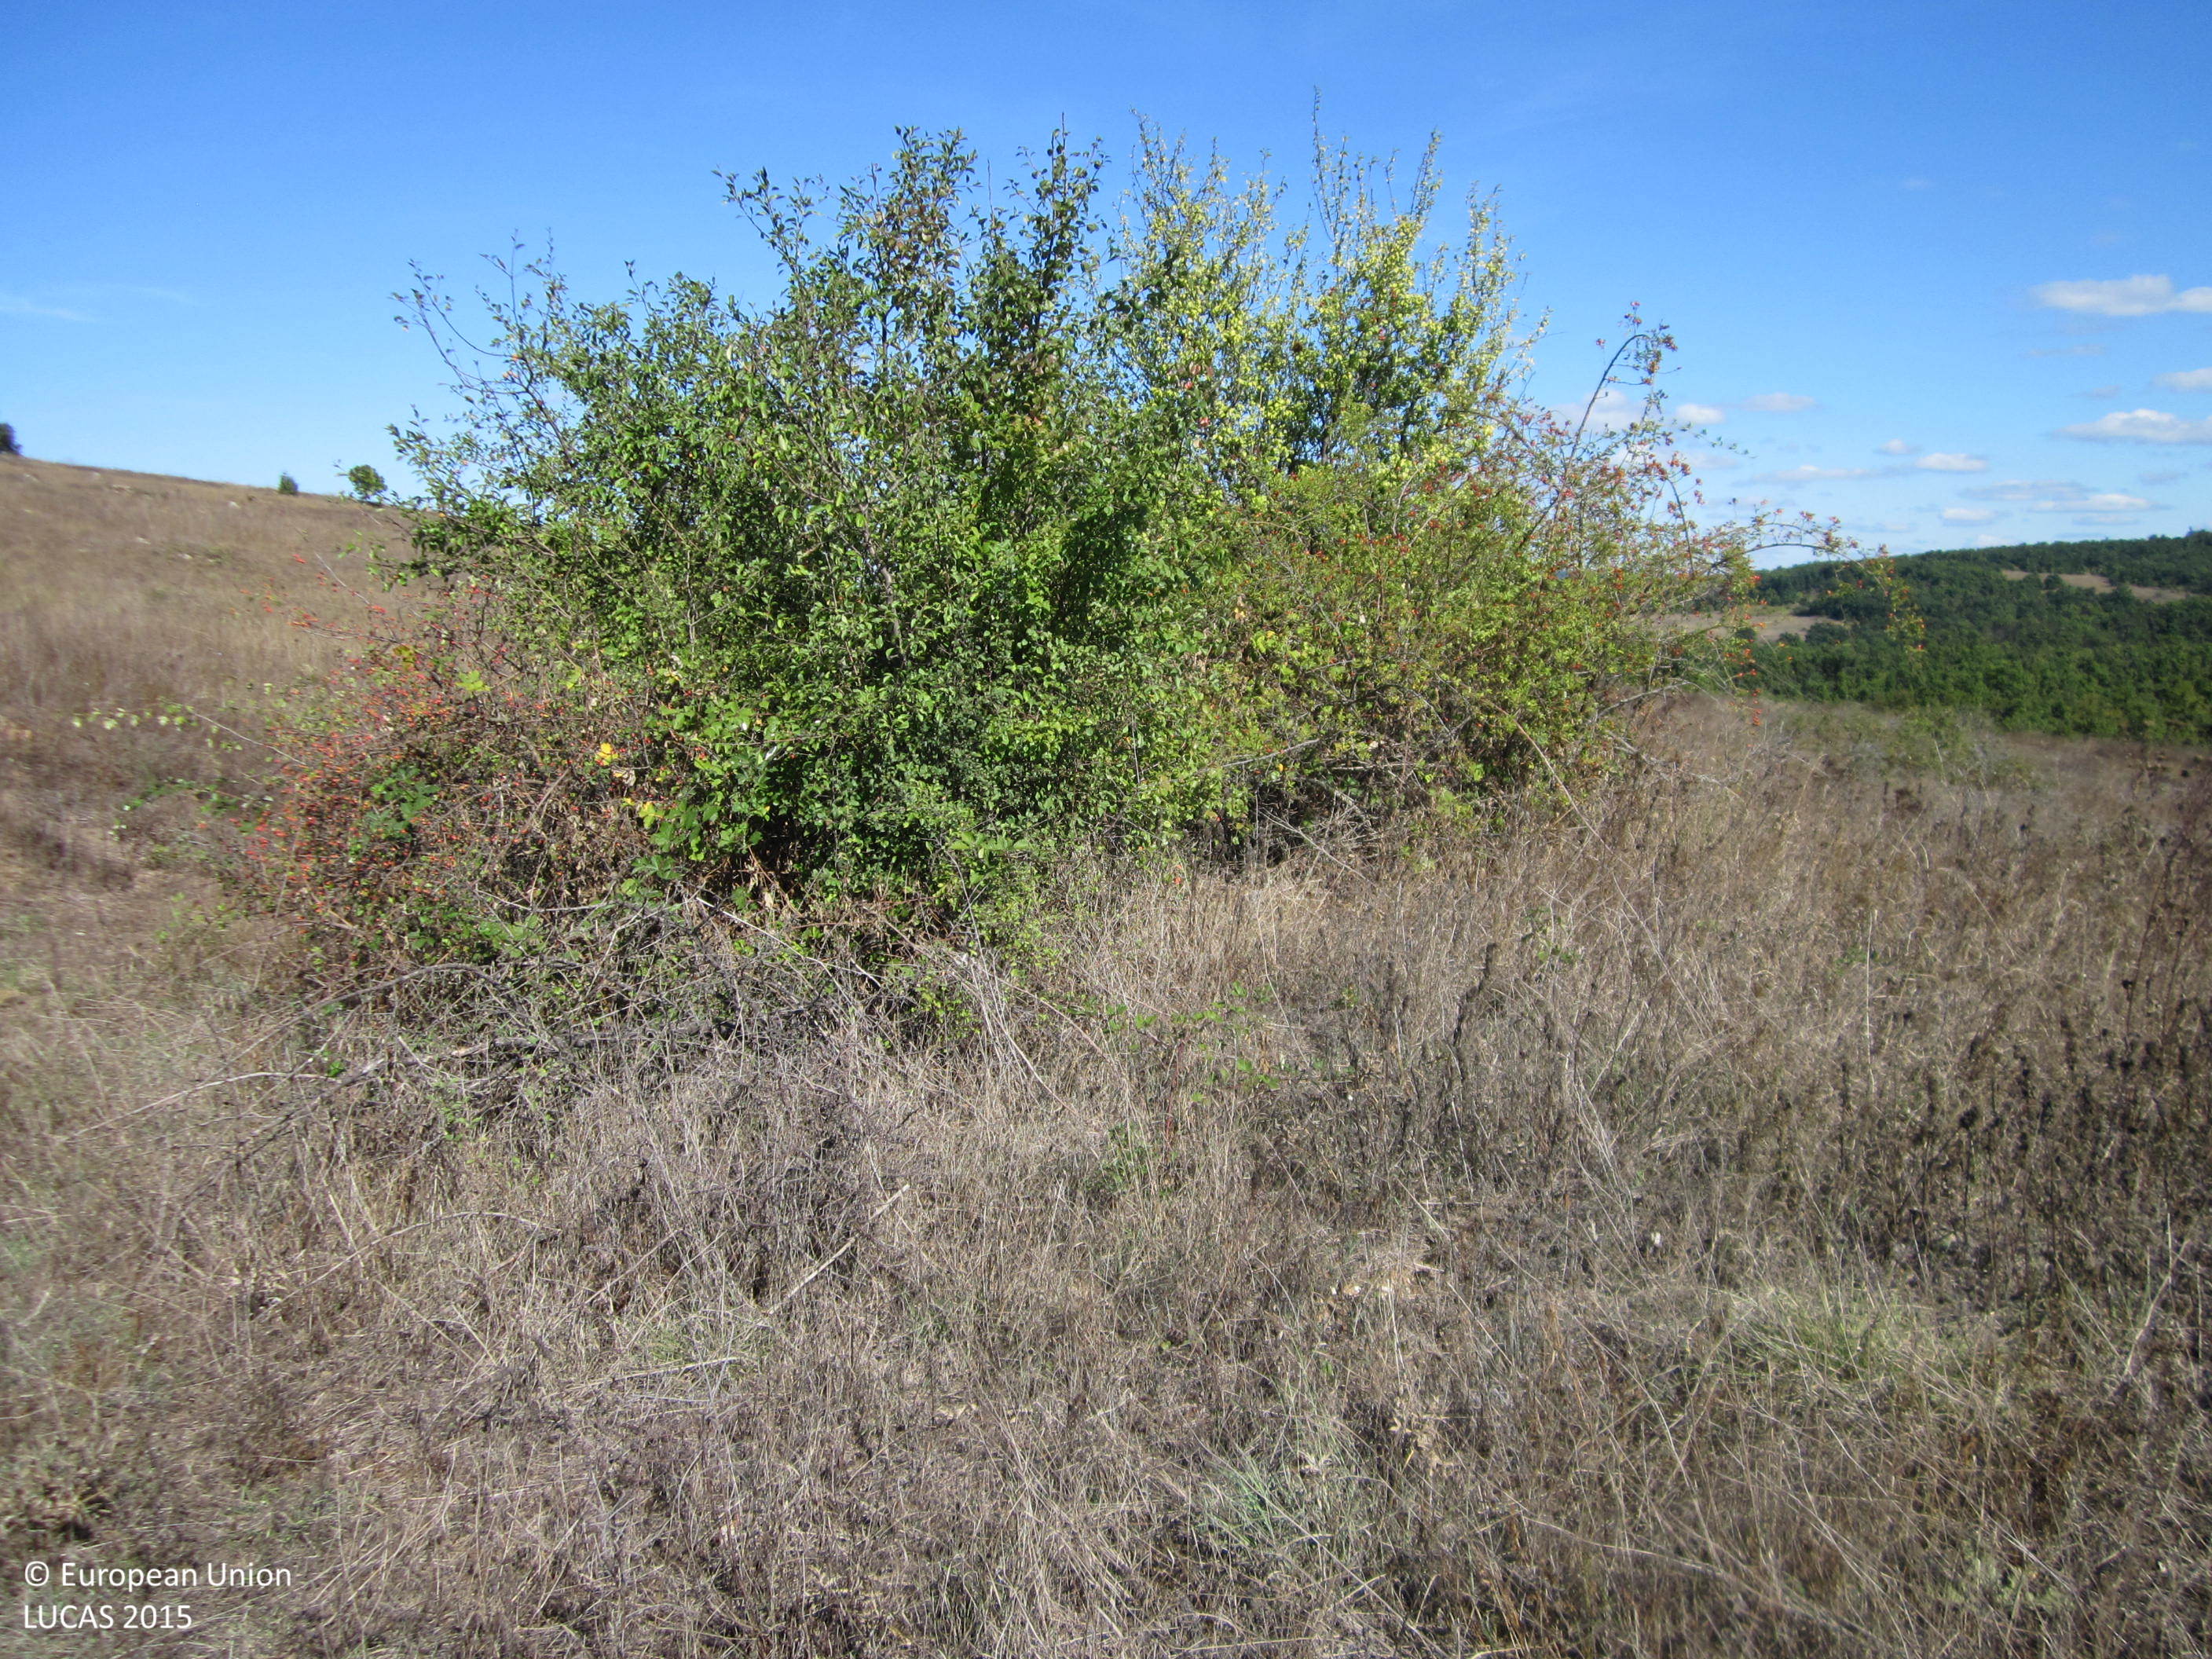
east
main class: Grassland
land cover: Grassland with sparse tree/shrub cover
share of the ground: > 75 %
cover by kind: herbaceous plants 90 %, broadleaved forest trees 5 %, shrubs 5 %
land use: Agriculture (excluding fallow land and kitchen gardens)
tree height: < 5 m
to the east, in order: Grassland with sparse tree/shrub cover; Grassland without tree/shrub cover; Grassland with sparse tree/shrub cover; Rocks and stones; Grassland without tree/shrub cover; Grassland with sparse tree/shrub cover
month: September
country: BG
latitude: 42.1496
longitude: 27.1792
